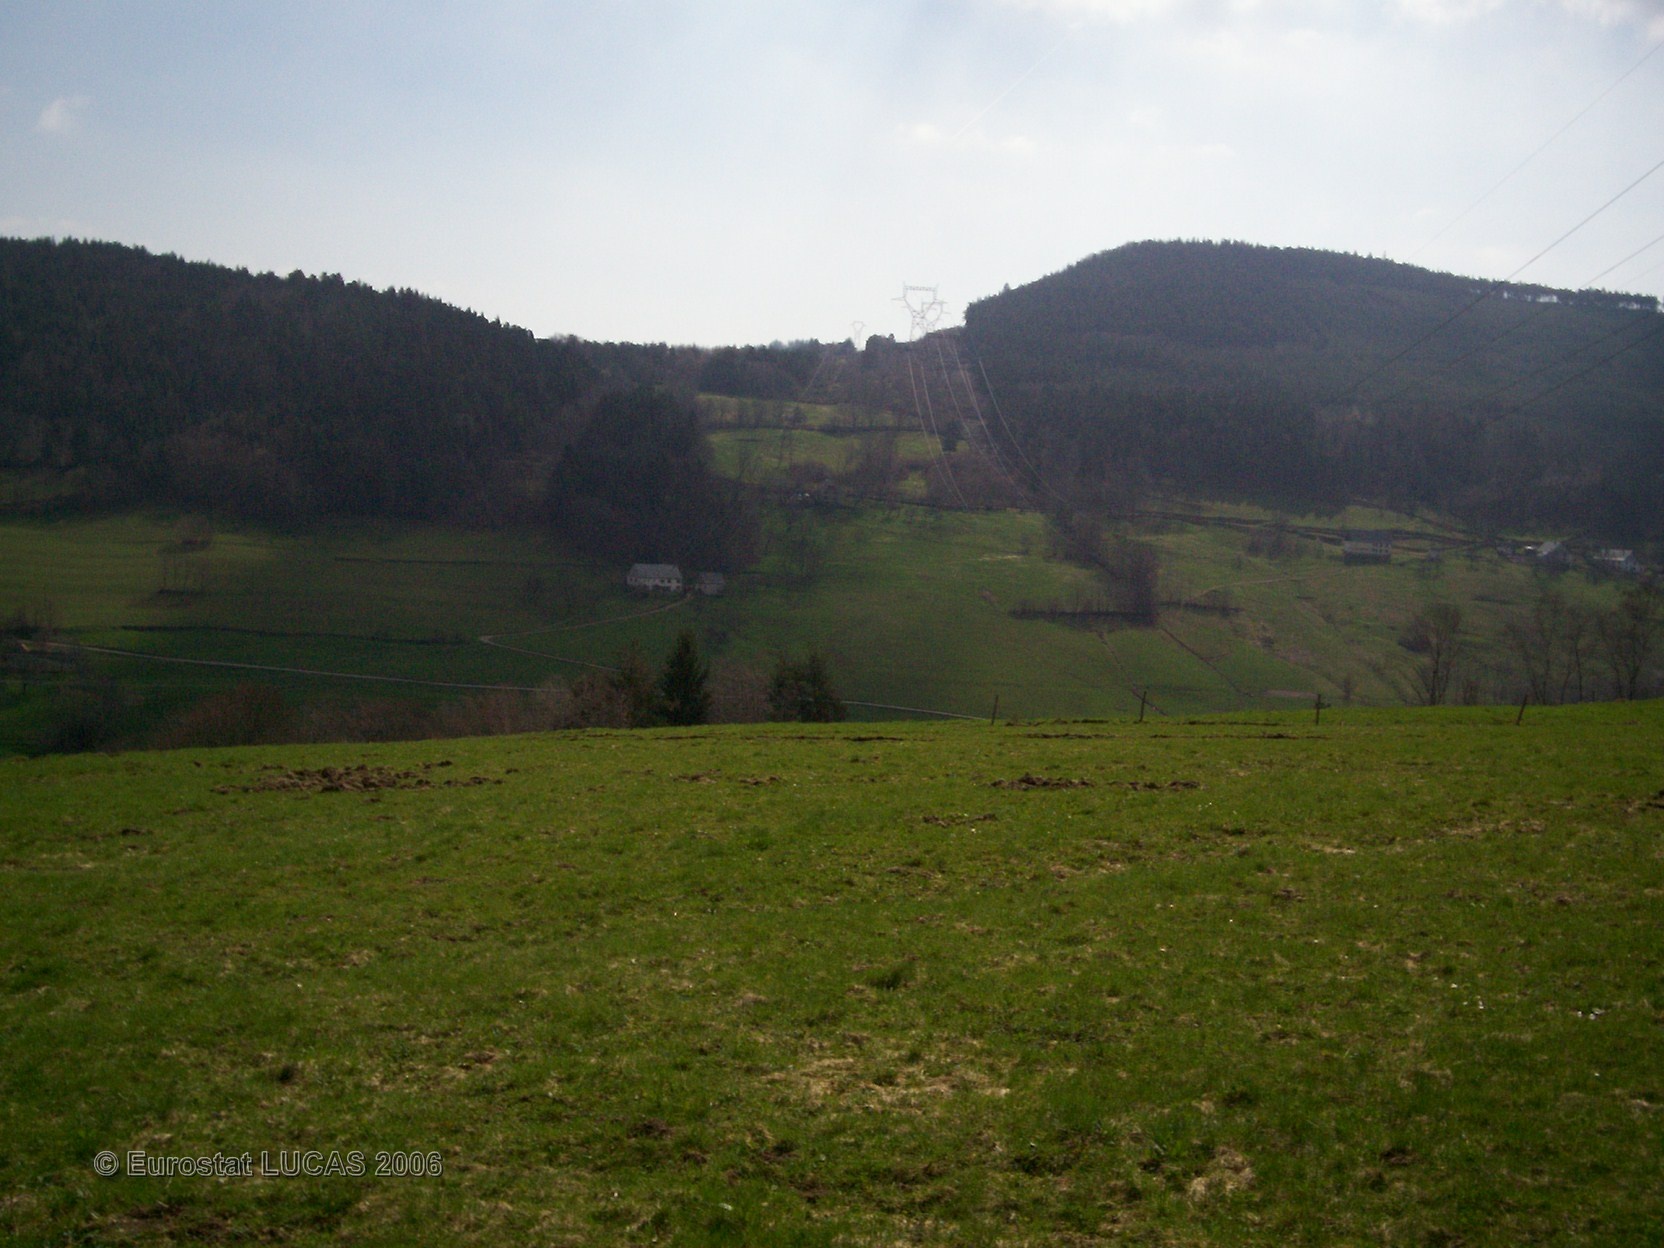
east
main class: Grassland
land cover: Grassland without tree/shrub cover
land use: Agriculture (excluding fallow land and kitchen gardens)
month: April
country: FR
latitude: 48.1144
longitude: 7.1400
